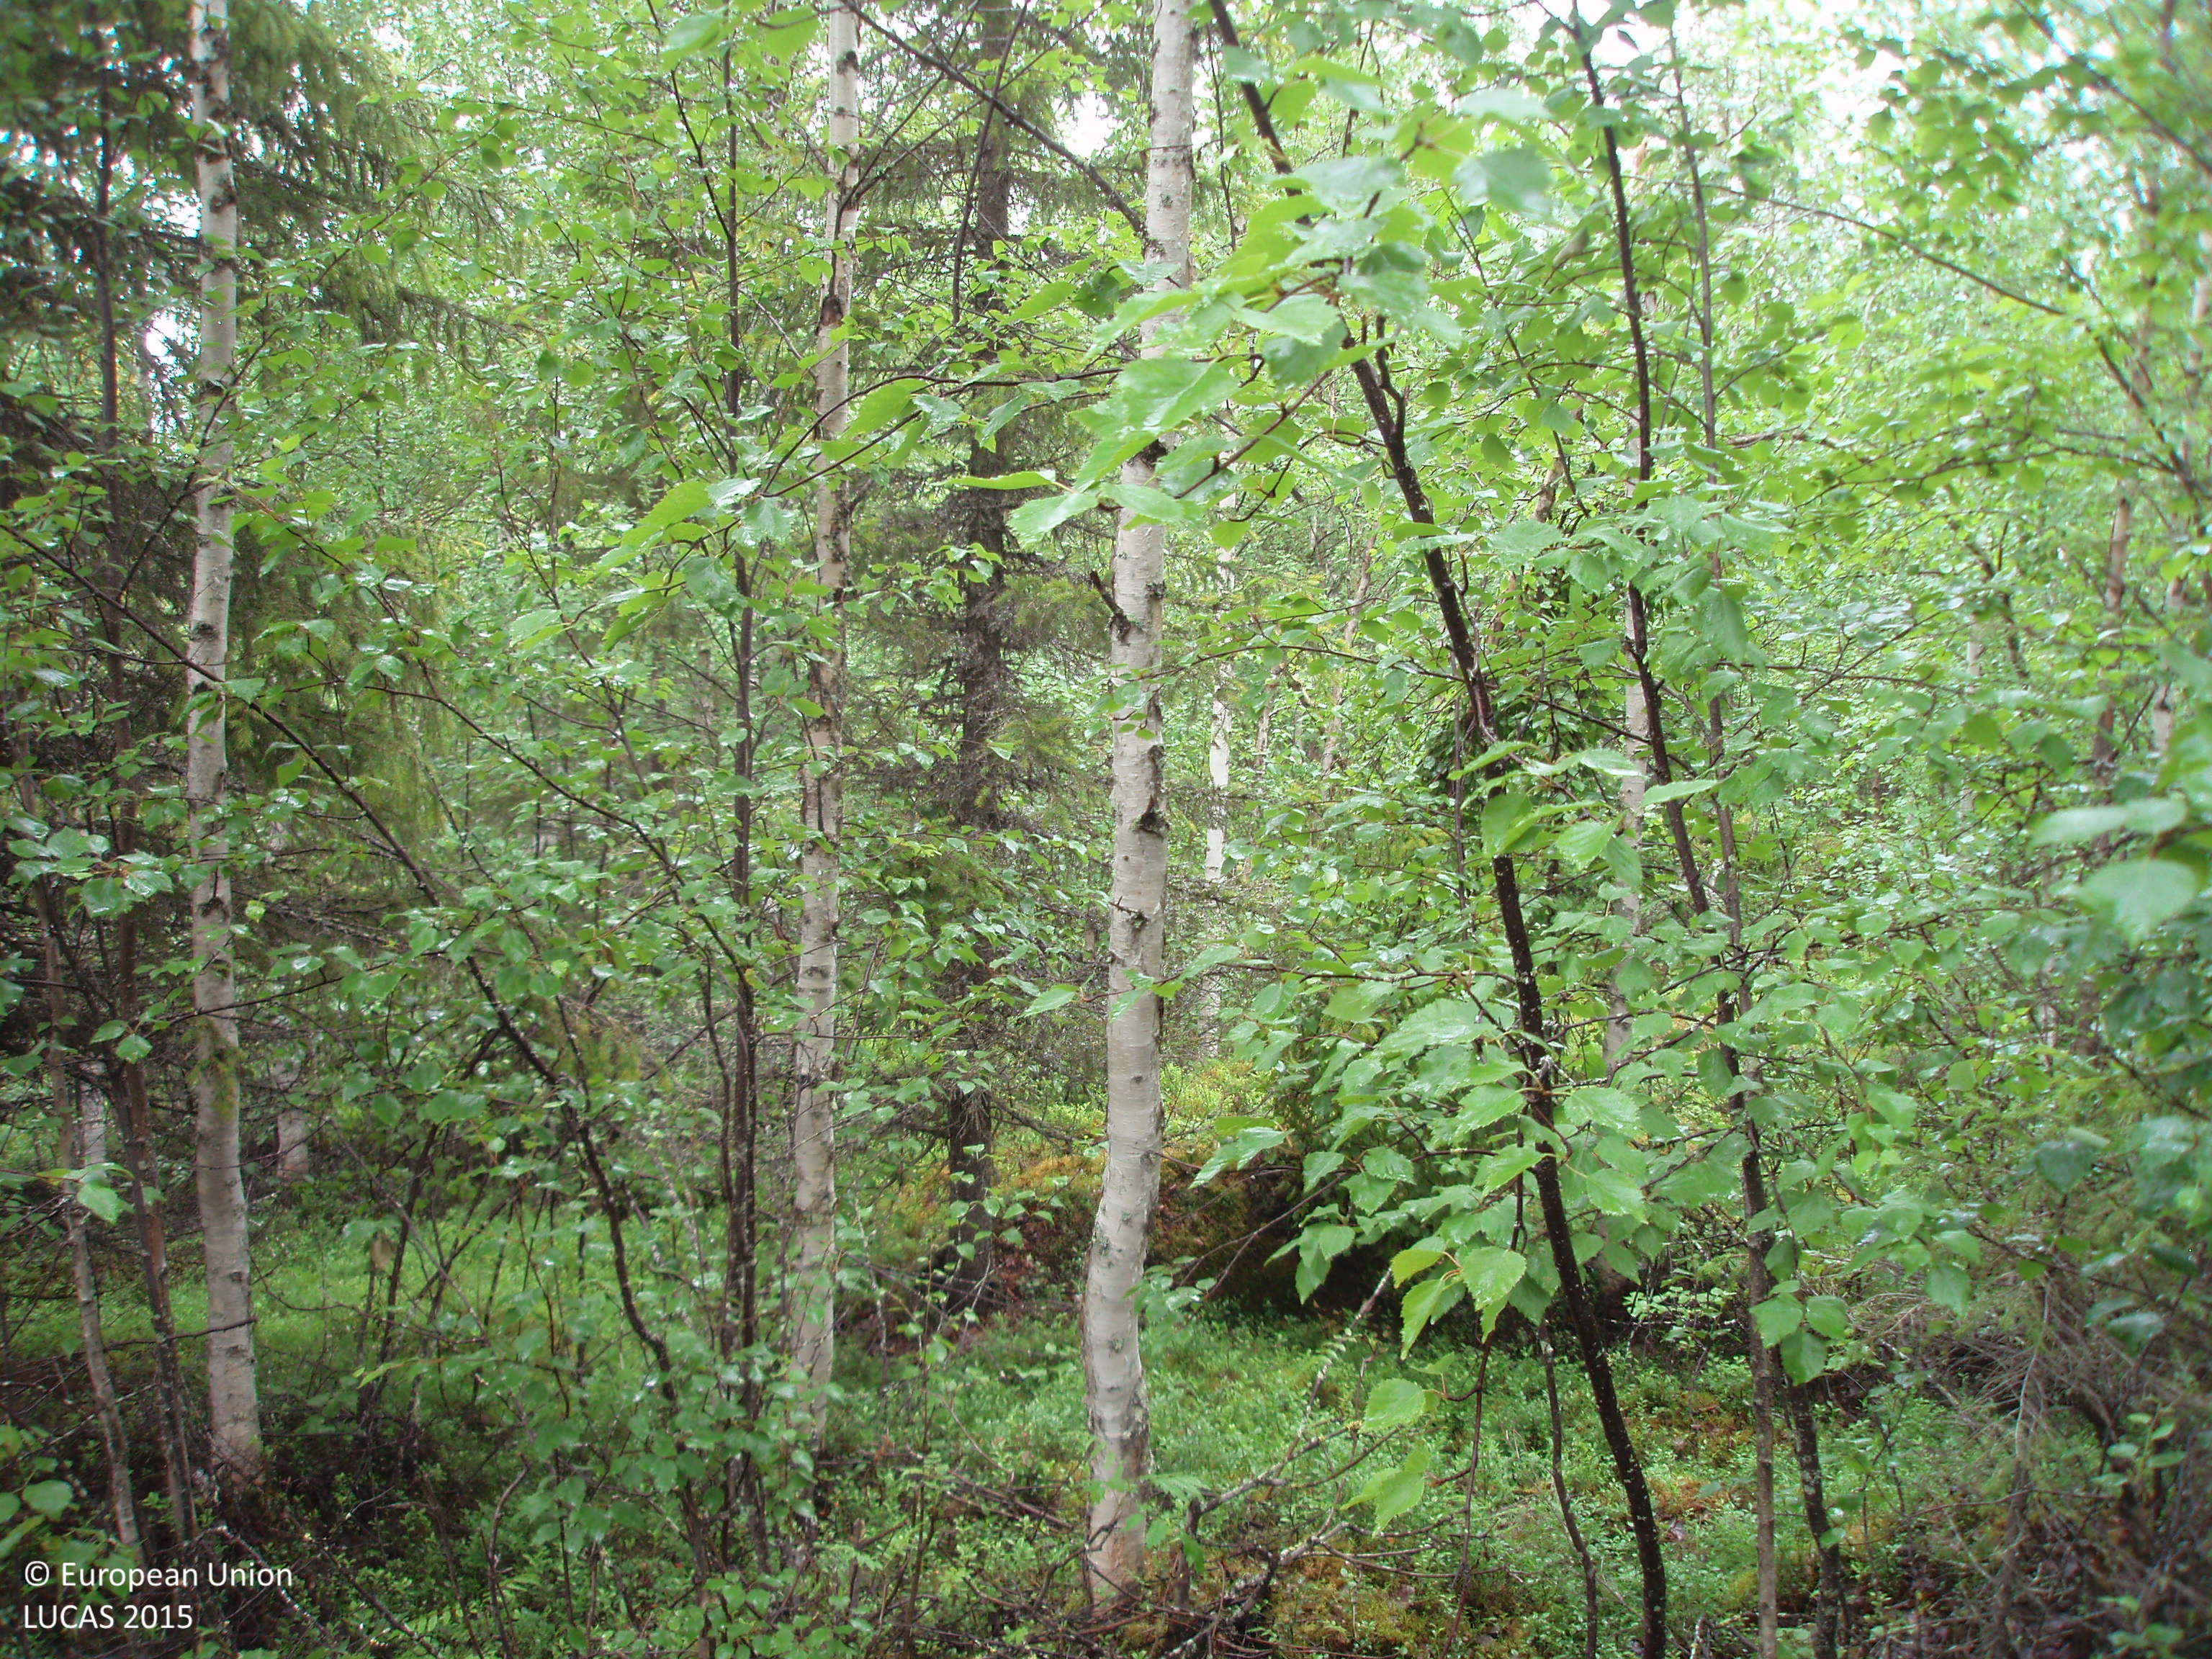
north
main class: Woodland
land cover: Broadleaved woodland
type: boreal forest
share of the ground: > 75 %
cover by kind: broadleaved forest trees 85 %, shrubs 10 %, coniferous forest trees 5 %
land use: Forestry
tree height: > 5 m
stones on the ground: < 10 %
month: July
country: FI
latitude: 66.7039
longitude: 28.2854
